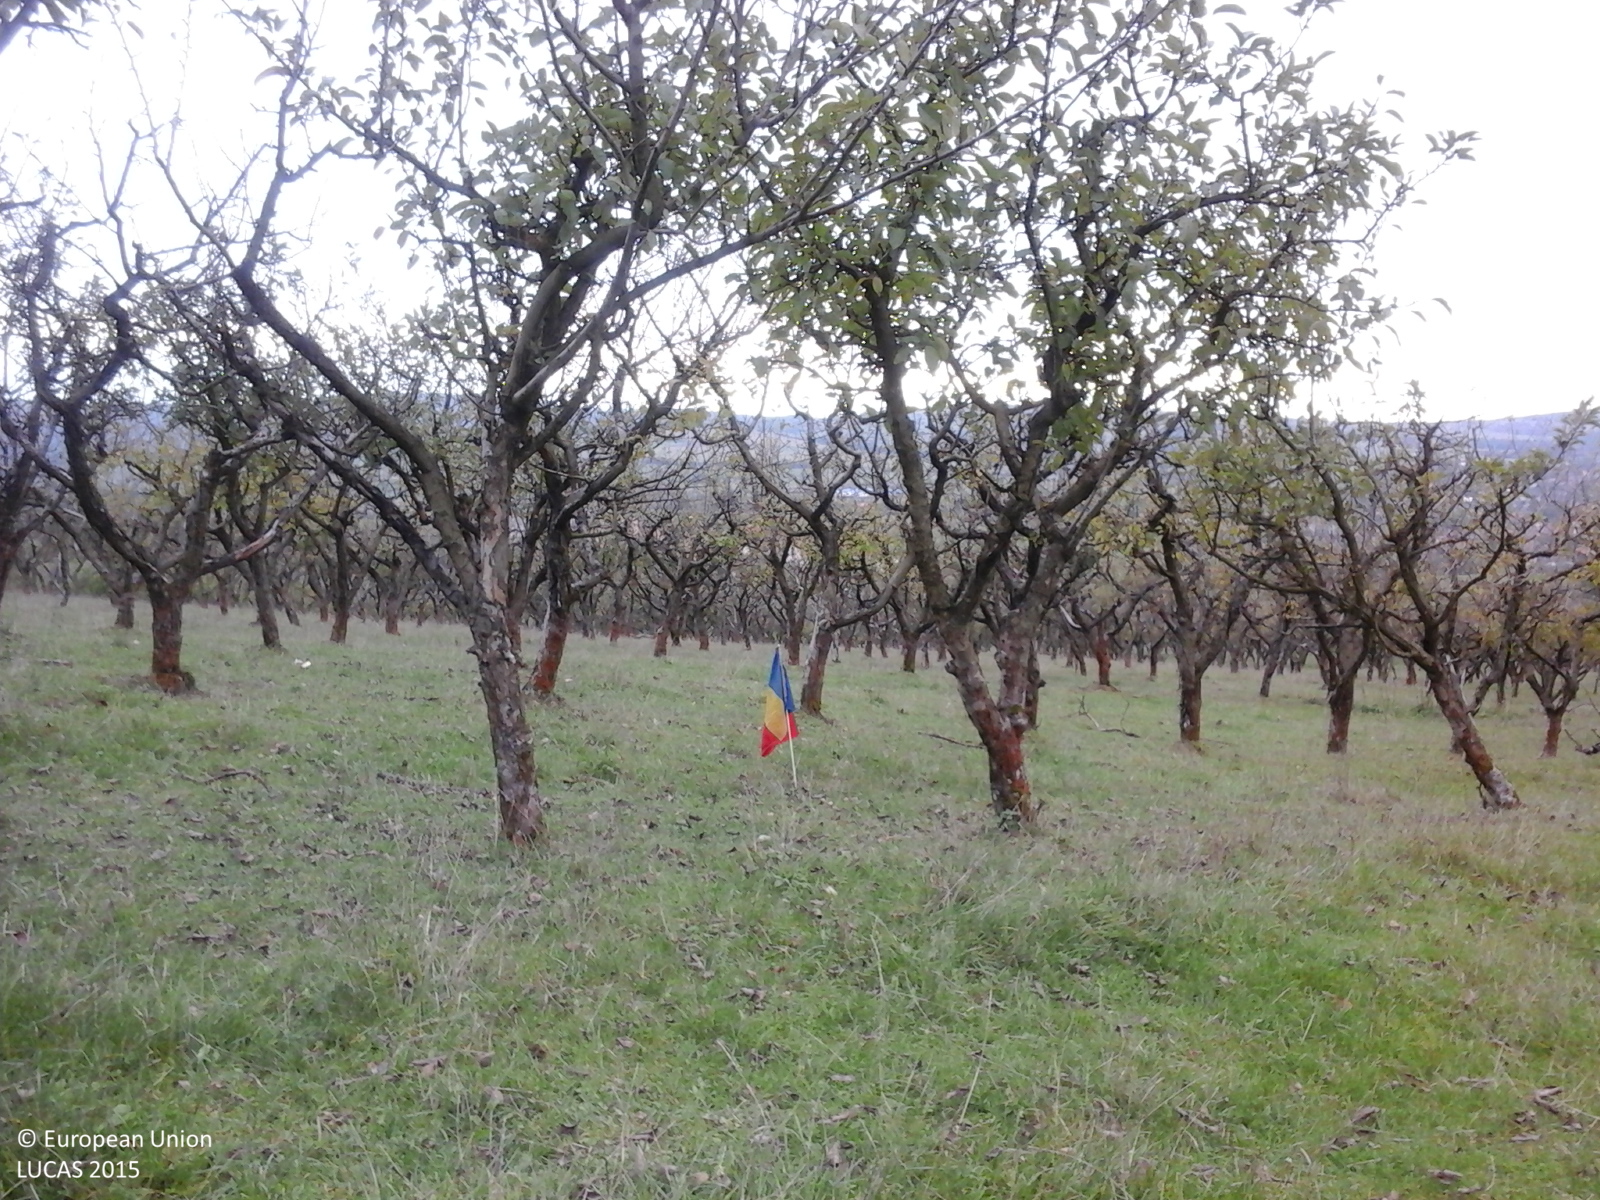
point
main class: Cropland
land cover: Apple fruit
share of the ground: > 75 %
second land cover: Grassland without tree/shrub cover
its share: > 75 %
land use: Agriculture (excluding fallow land and kitchen gardens)
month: October
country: RO
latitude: 45.9149
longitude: 24.8256
